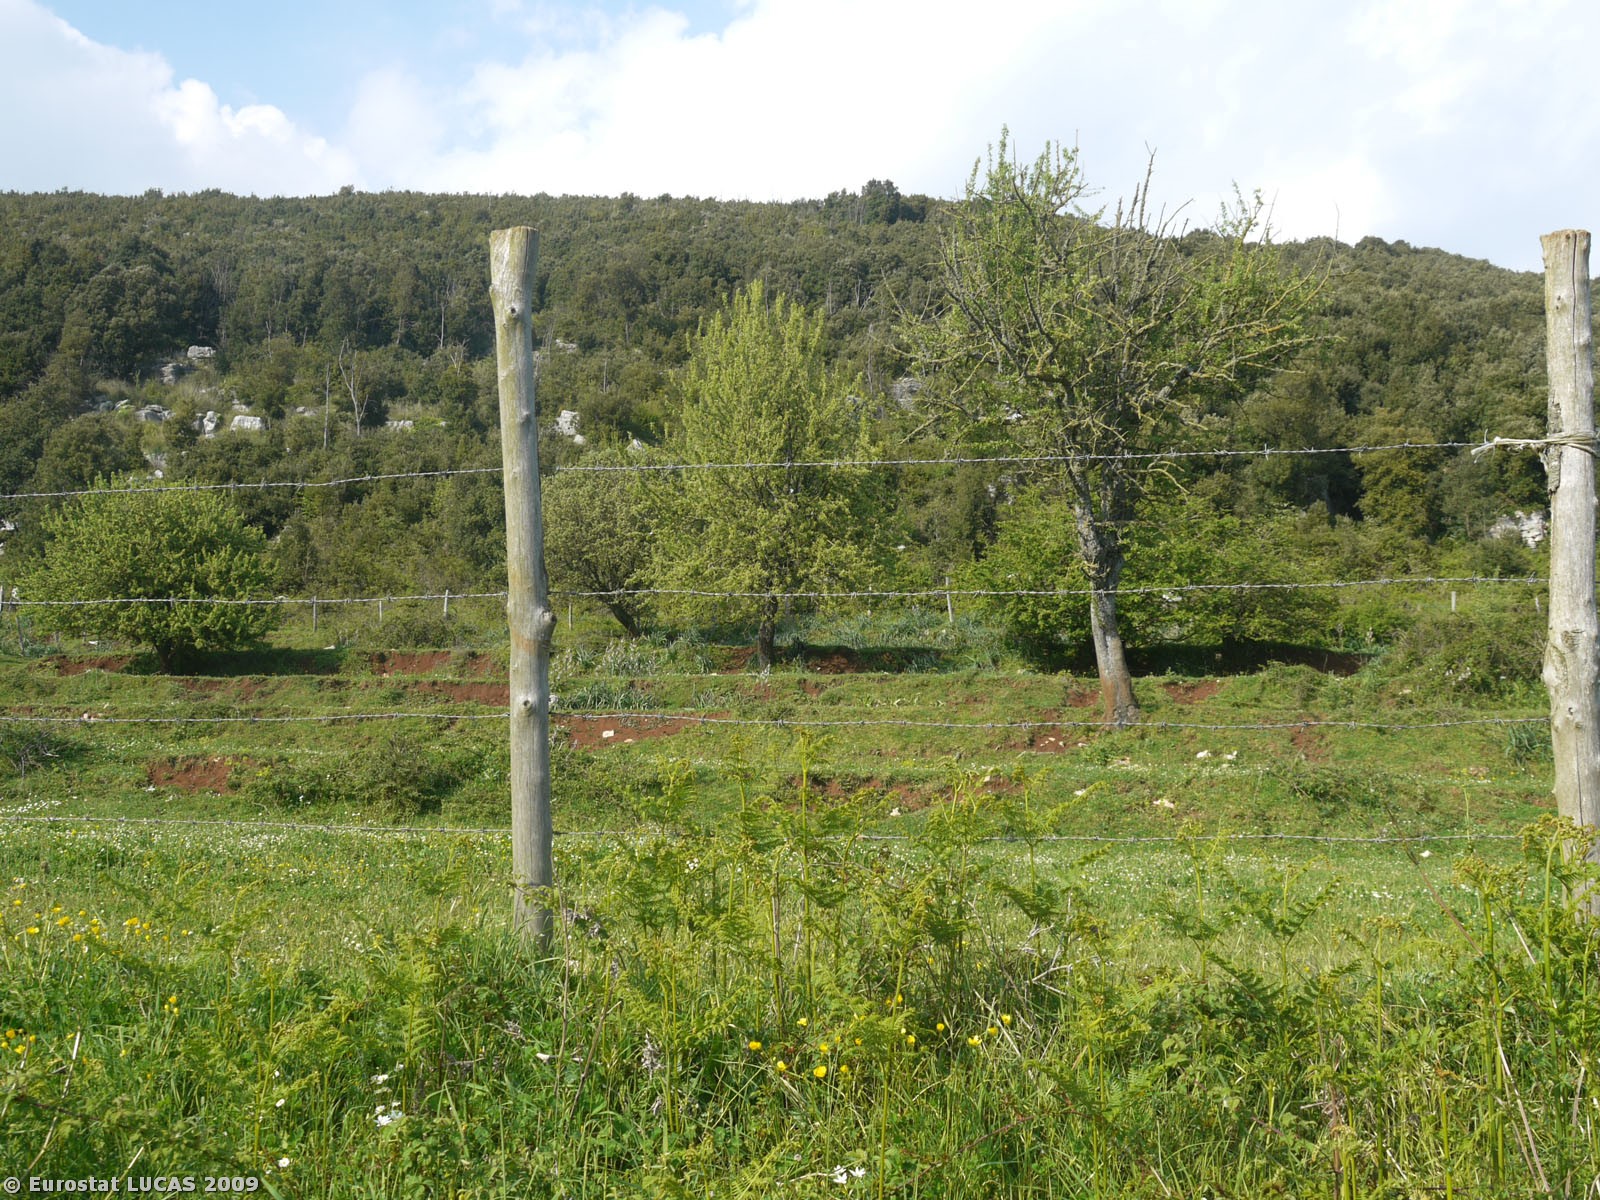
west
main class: Woodland
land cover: Broadleaved woodland
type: broadleaved evergreen forest
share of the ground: > 75 %
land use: Agriculture (excluding fallow land and kitchen gardens)
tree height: > 5 m
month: May
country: IT
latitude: 41.4444
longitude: 13.2548
